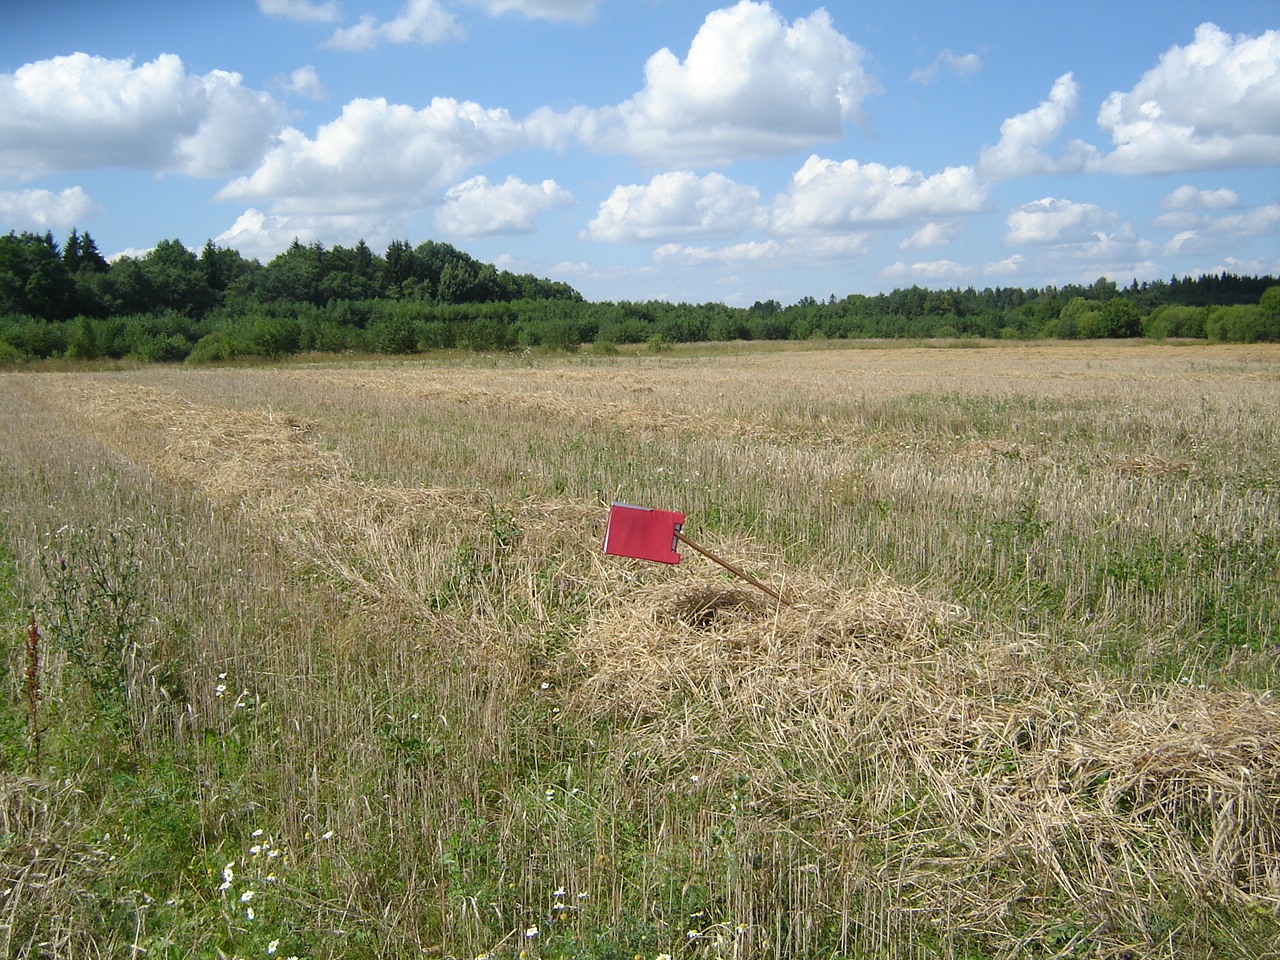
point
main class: Cropland
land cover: Durum wheat
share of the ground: > 75 %
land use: Agriculture (excluding fallow land and kitchen gardens)
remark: Harvested field
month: August
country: LT
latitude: 54.9975
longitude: 24.9150
